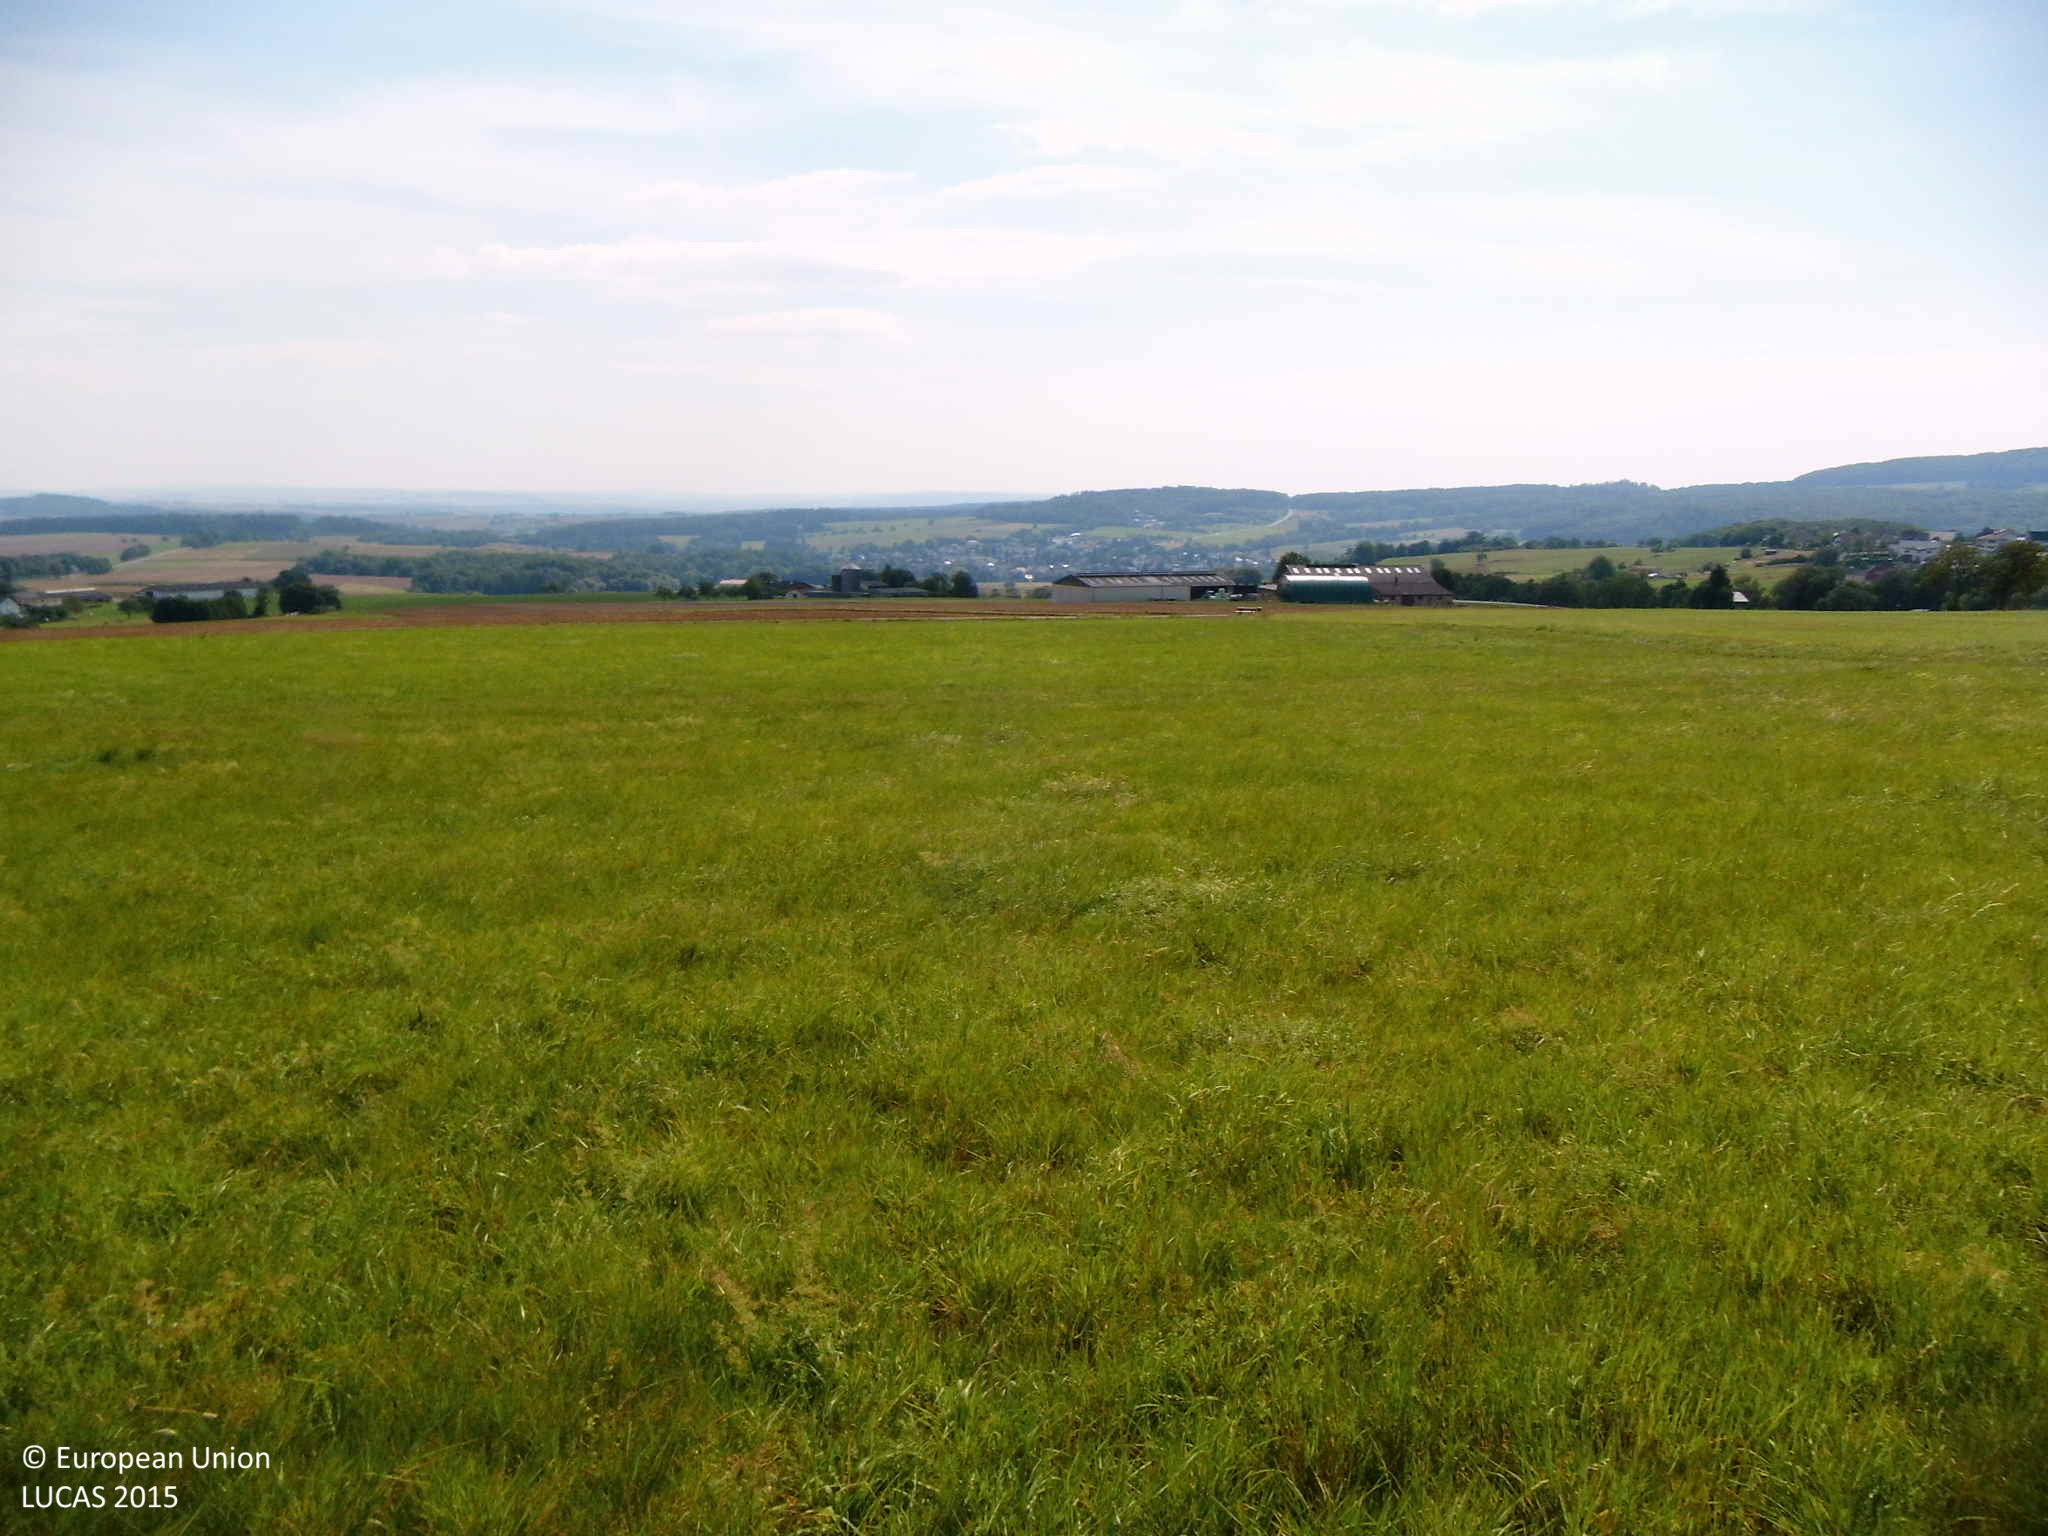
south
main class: Grassland
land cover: Grassland without tree/shrub cover
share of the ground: > 75 %
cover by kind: herbaceous plants 95 %, unconsolidated bare surface 5 %
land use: Agriculture (excluding fallow land and kitchen gardens)
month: August
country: DE
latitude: 50.5087
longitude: 8.0121
